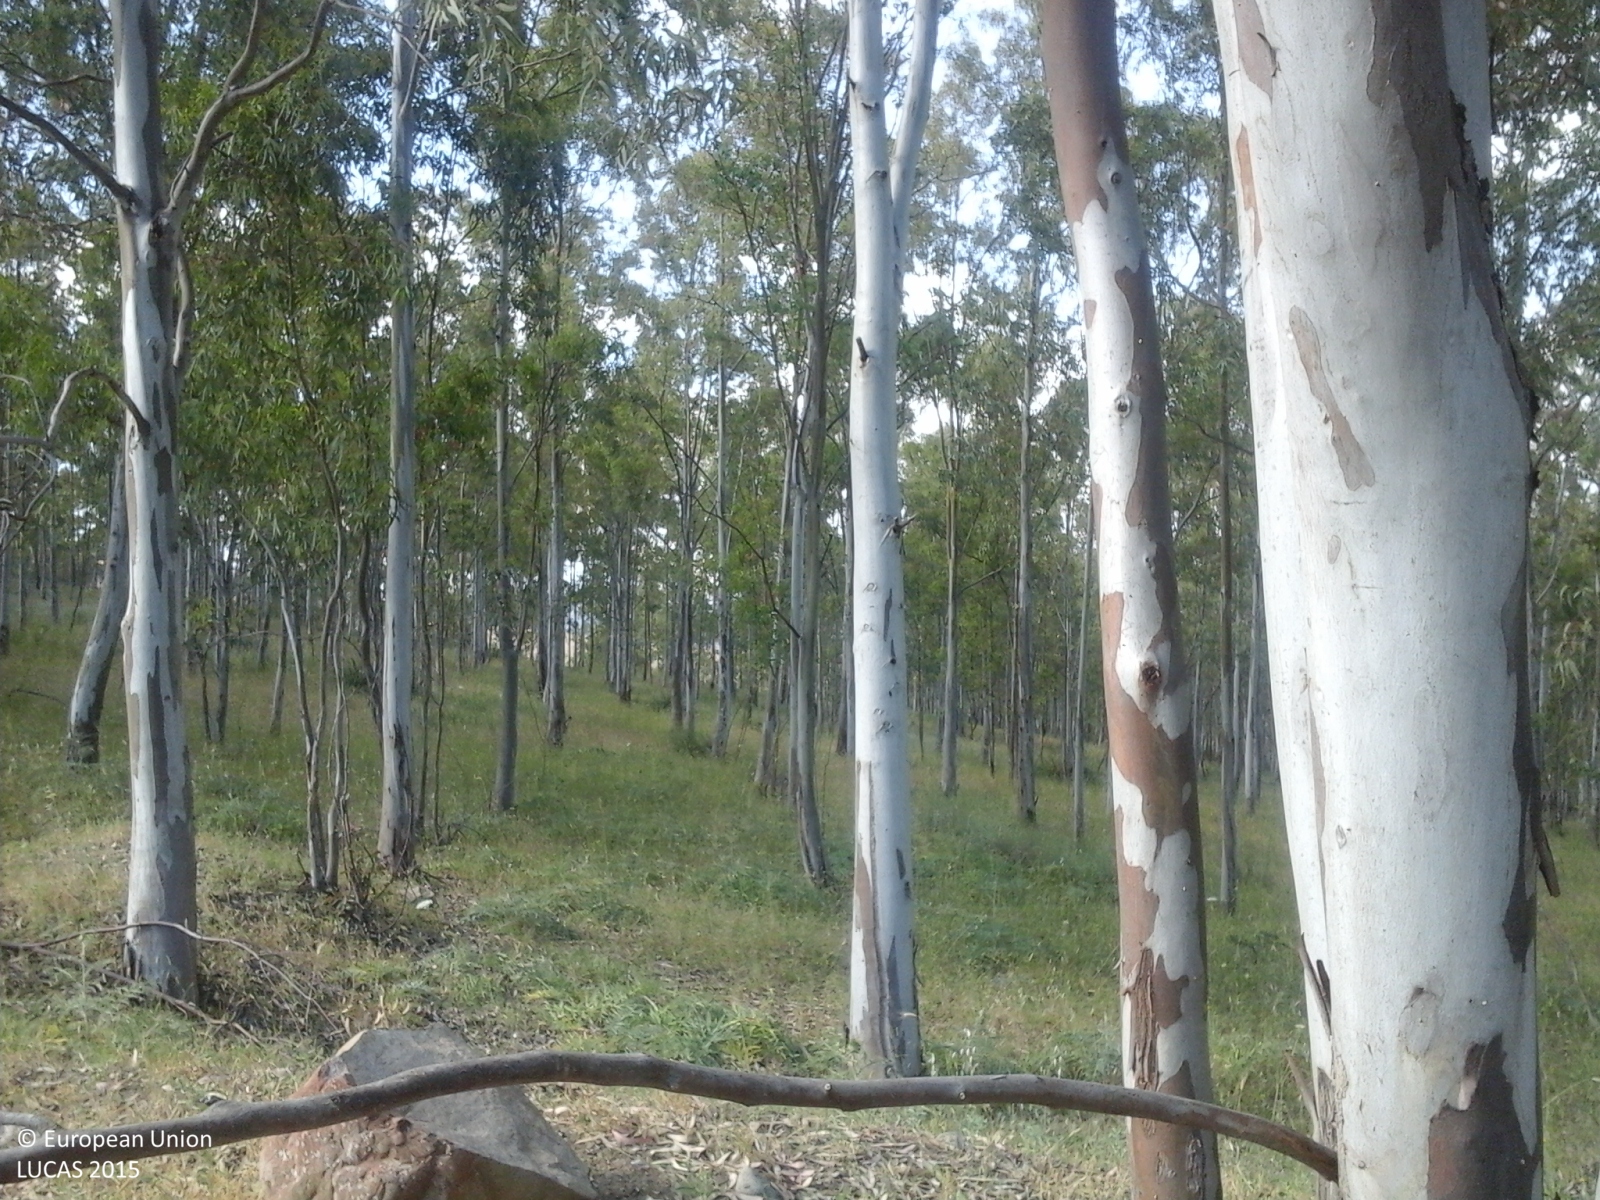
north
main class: Woodland
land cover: Broadleaved woodland
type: exotic forest
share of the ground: > 75 %
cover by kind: broadleaved forest trees 100 %
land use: Forestry
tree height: > 5 m
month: May
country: IT
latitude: 37.5672
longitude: 14.1246
